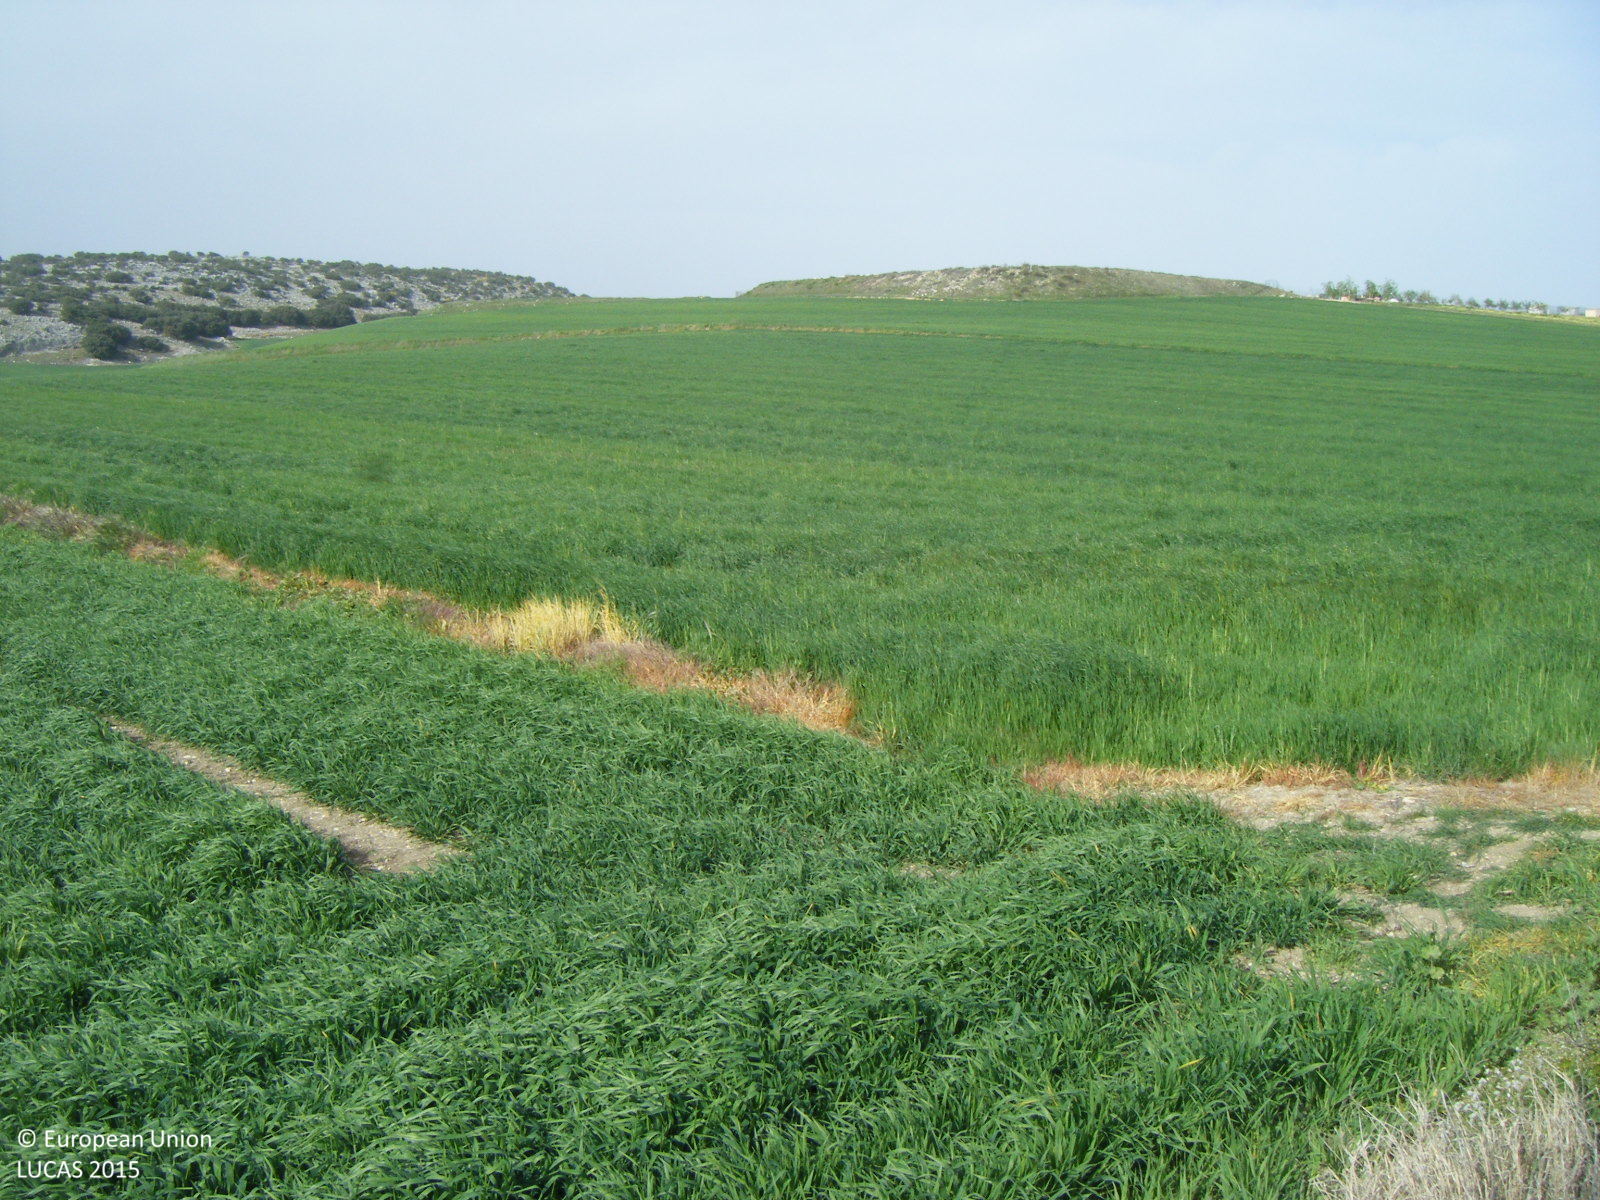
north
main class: Shrubland
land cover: Shrubland without tree cover
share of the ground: 50 - 75 %
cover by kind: shrubs 50 %, herbaceous plants 30 %, consolidated bare surface 20 %
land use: Agriculture (excluding fallow land and kitchen gardens)
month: April
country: ES
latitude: 37.0290
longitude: -4.0541
